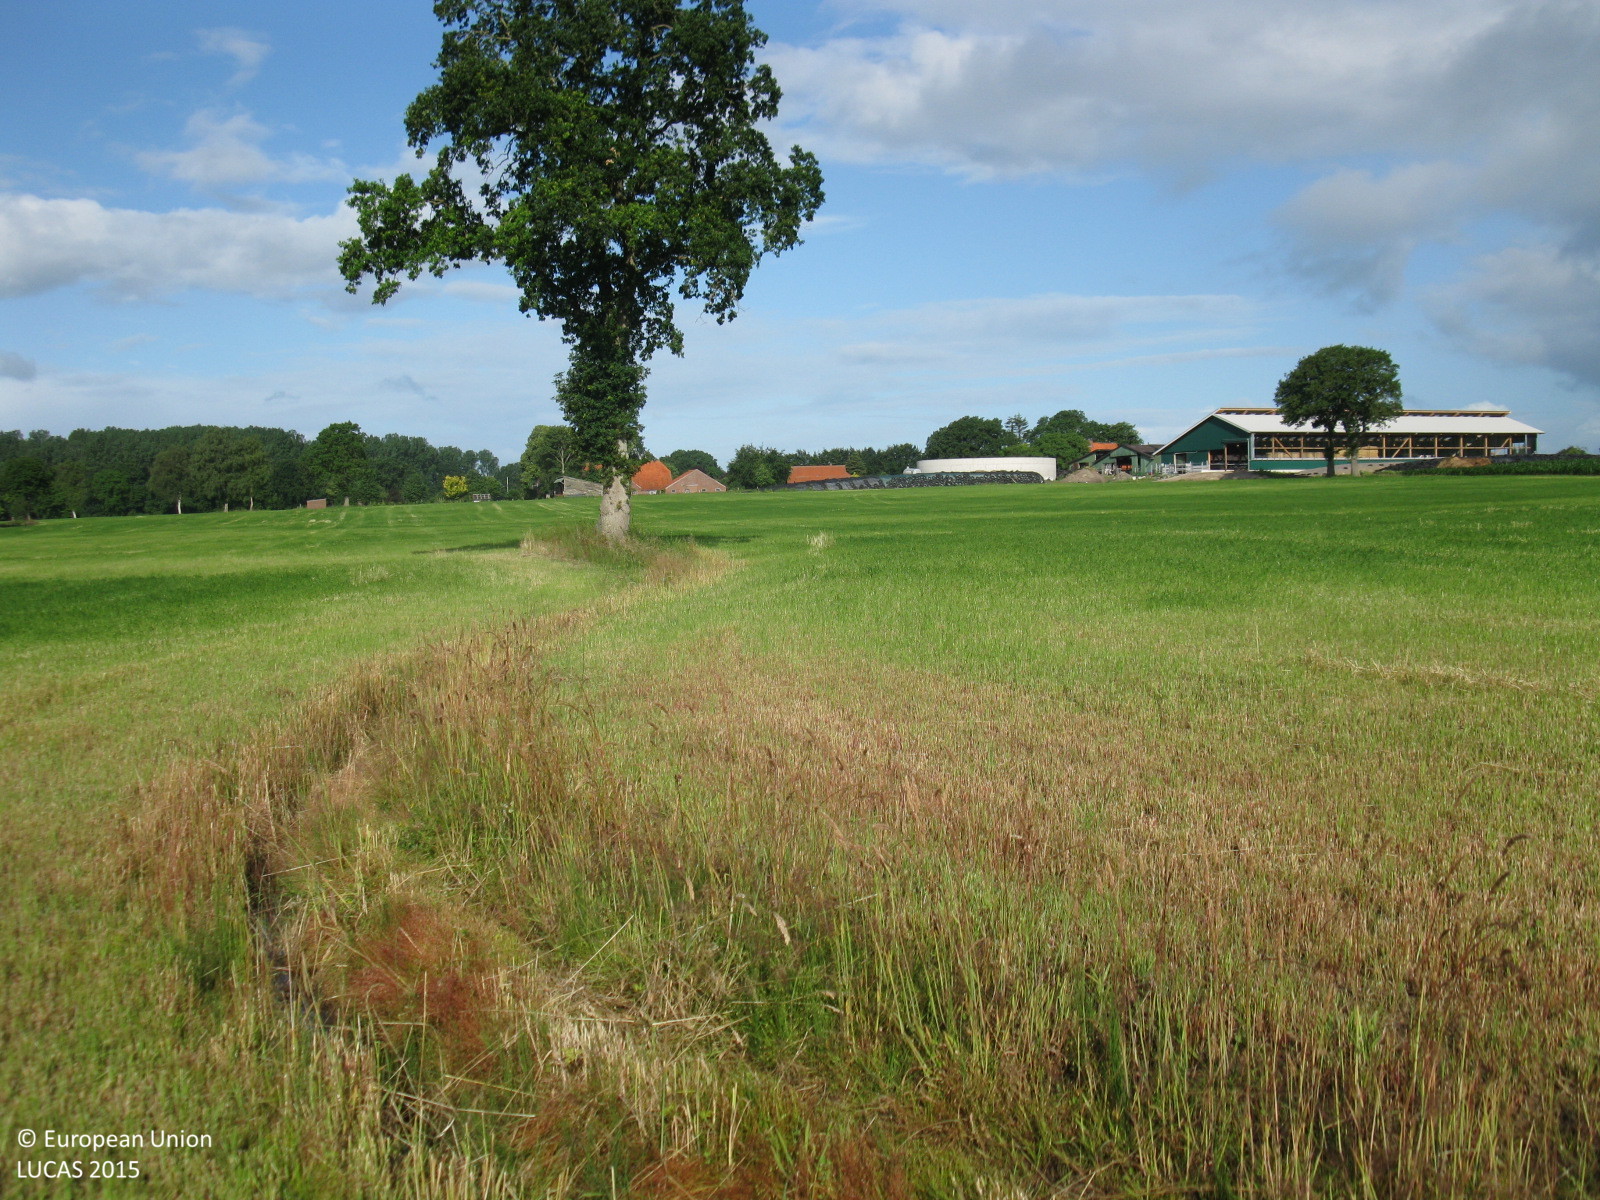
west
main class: Grassland
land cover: Grassland without tree/shrub cover
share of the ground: > 75 %
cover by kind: herbaceous plants 100 %
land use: Agriculture (excluding fallow land and kitchen gardens)
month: July
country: DE
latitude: 53.4029
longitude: 7.9701
